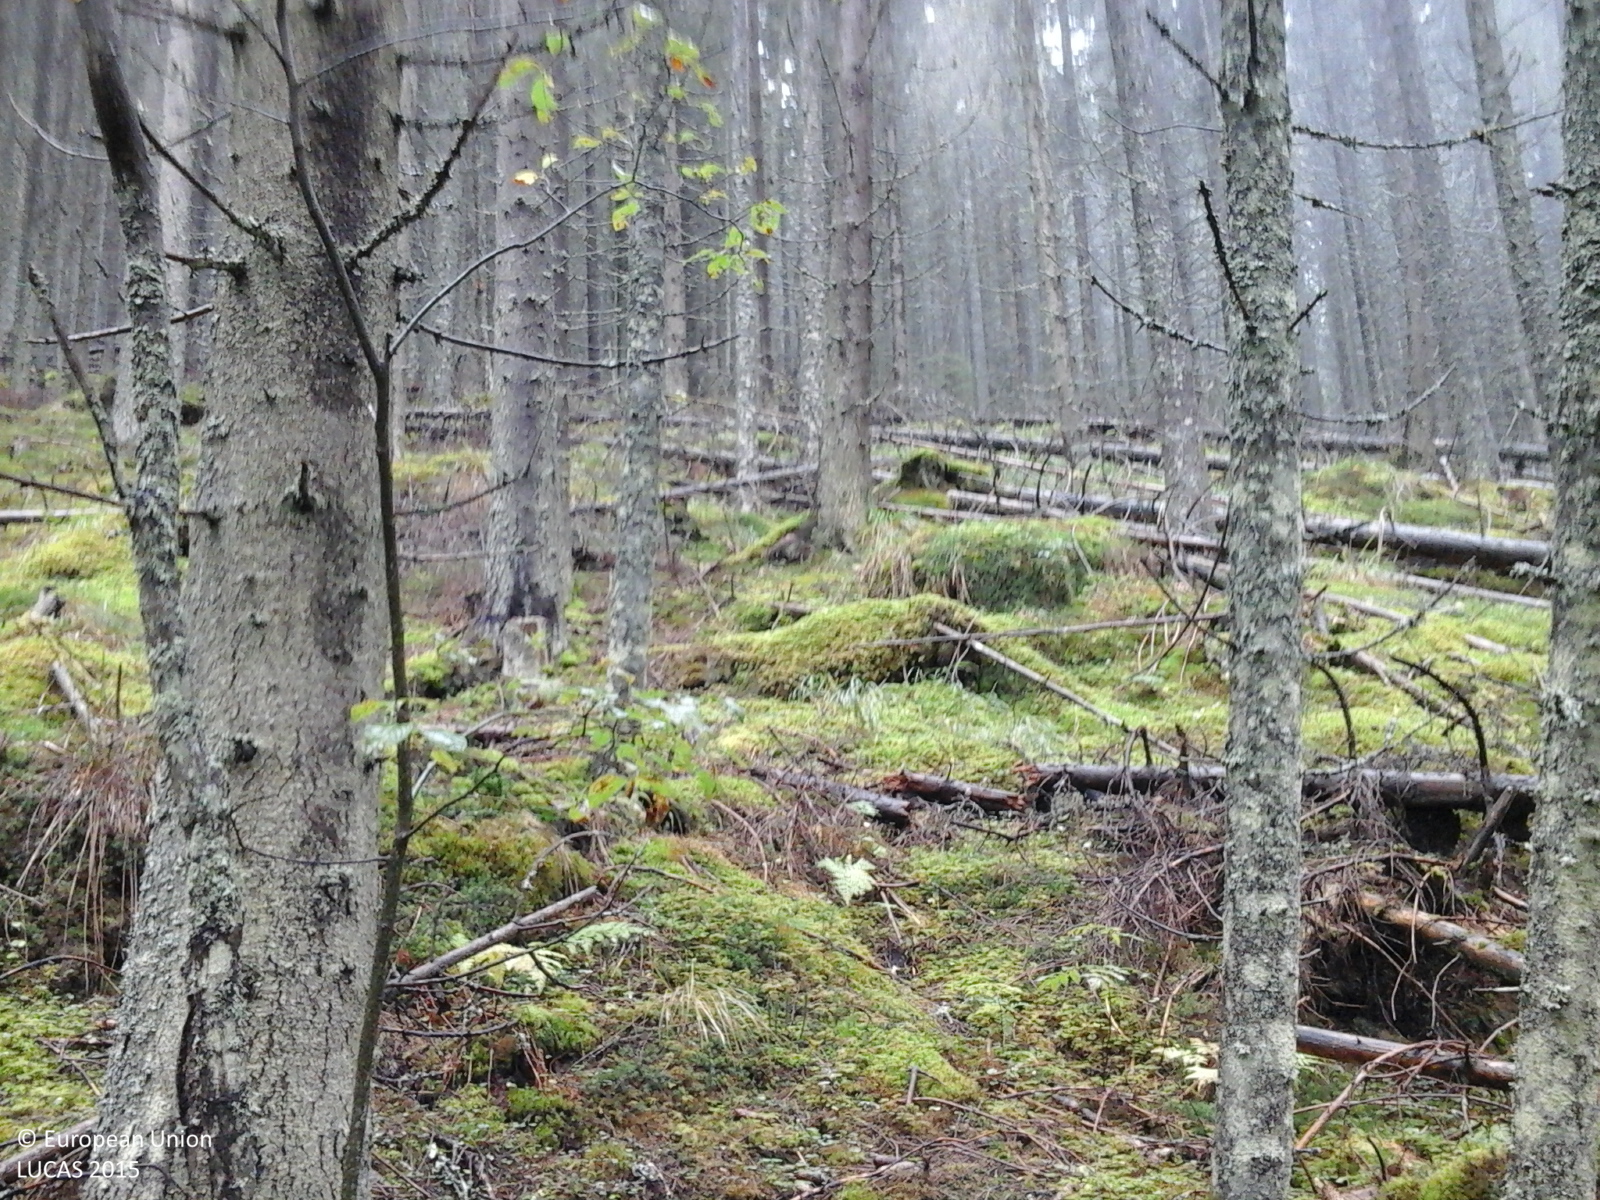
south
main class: Woodland
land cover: Spruce dominated coniferous woodland
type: alpine coniferous forest
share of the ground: > 75 %
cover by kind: coniferous forest trees 100 %
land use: Forestry
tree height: > 5 m
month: September
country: RO
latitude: 45.5969
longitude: 23.6662
